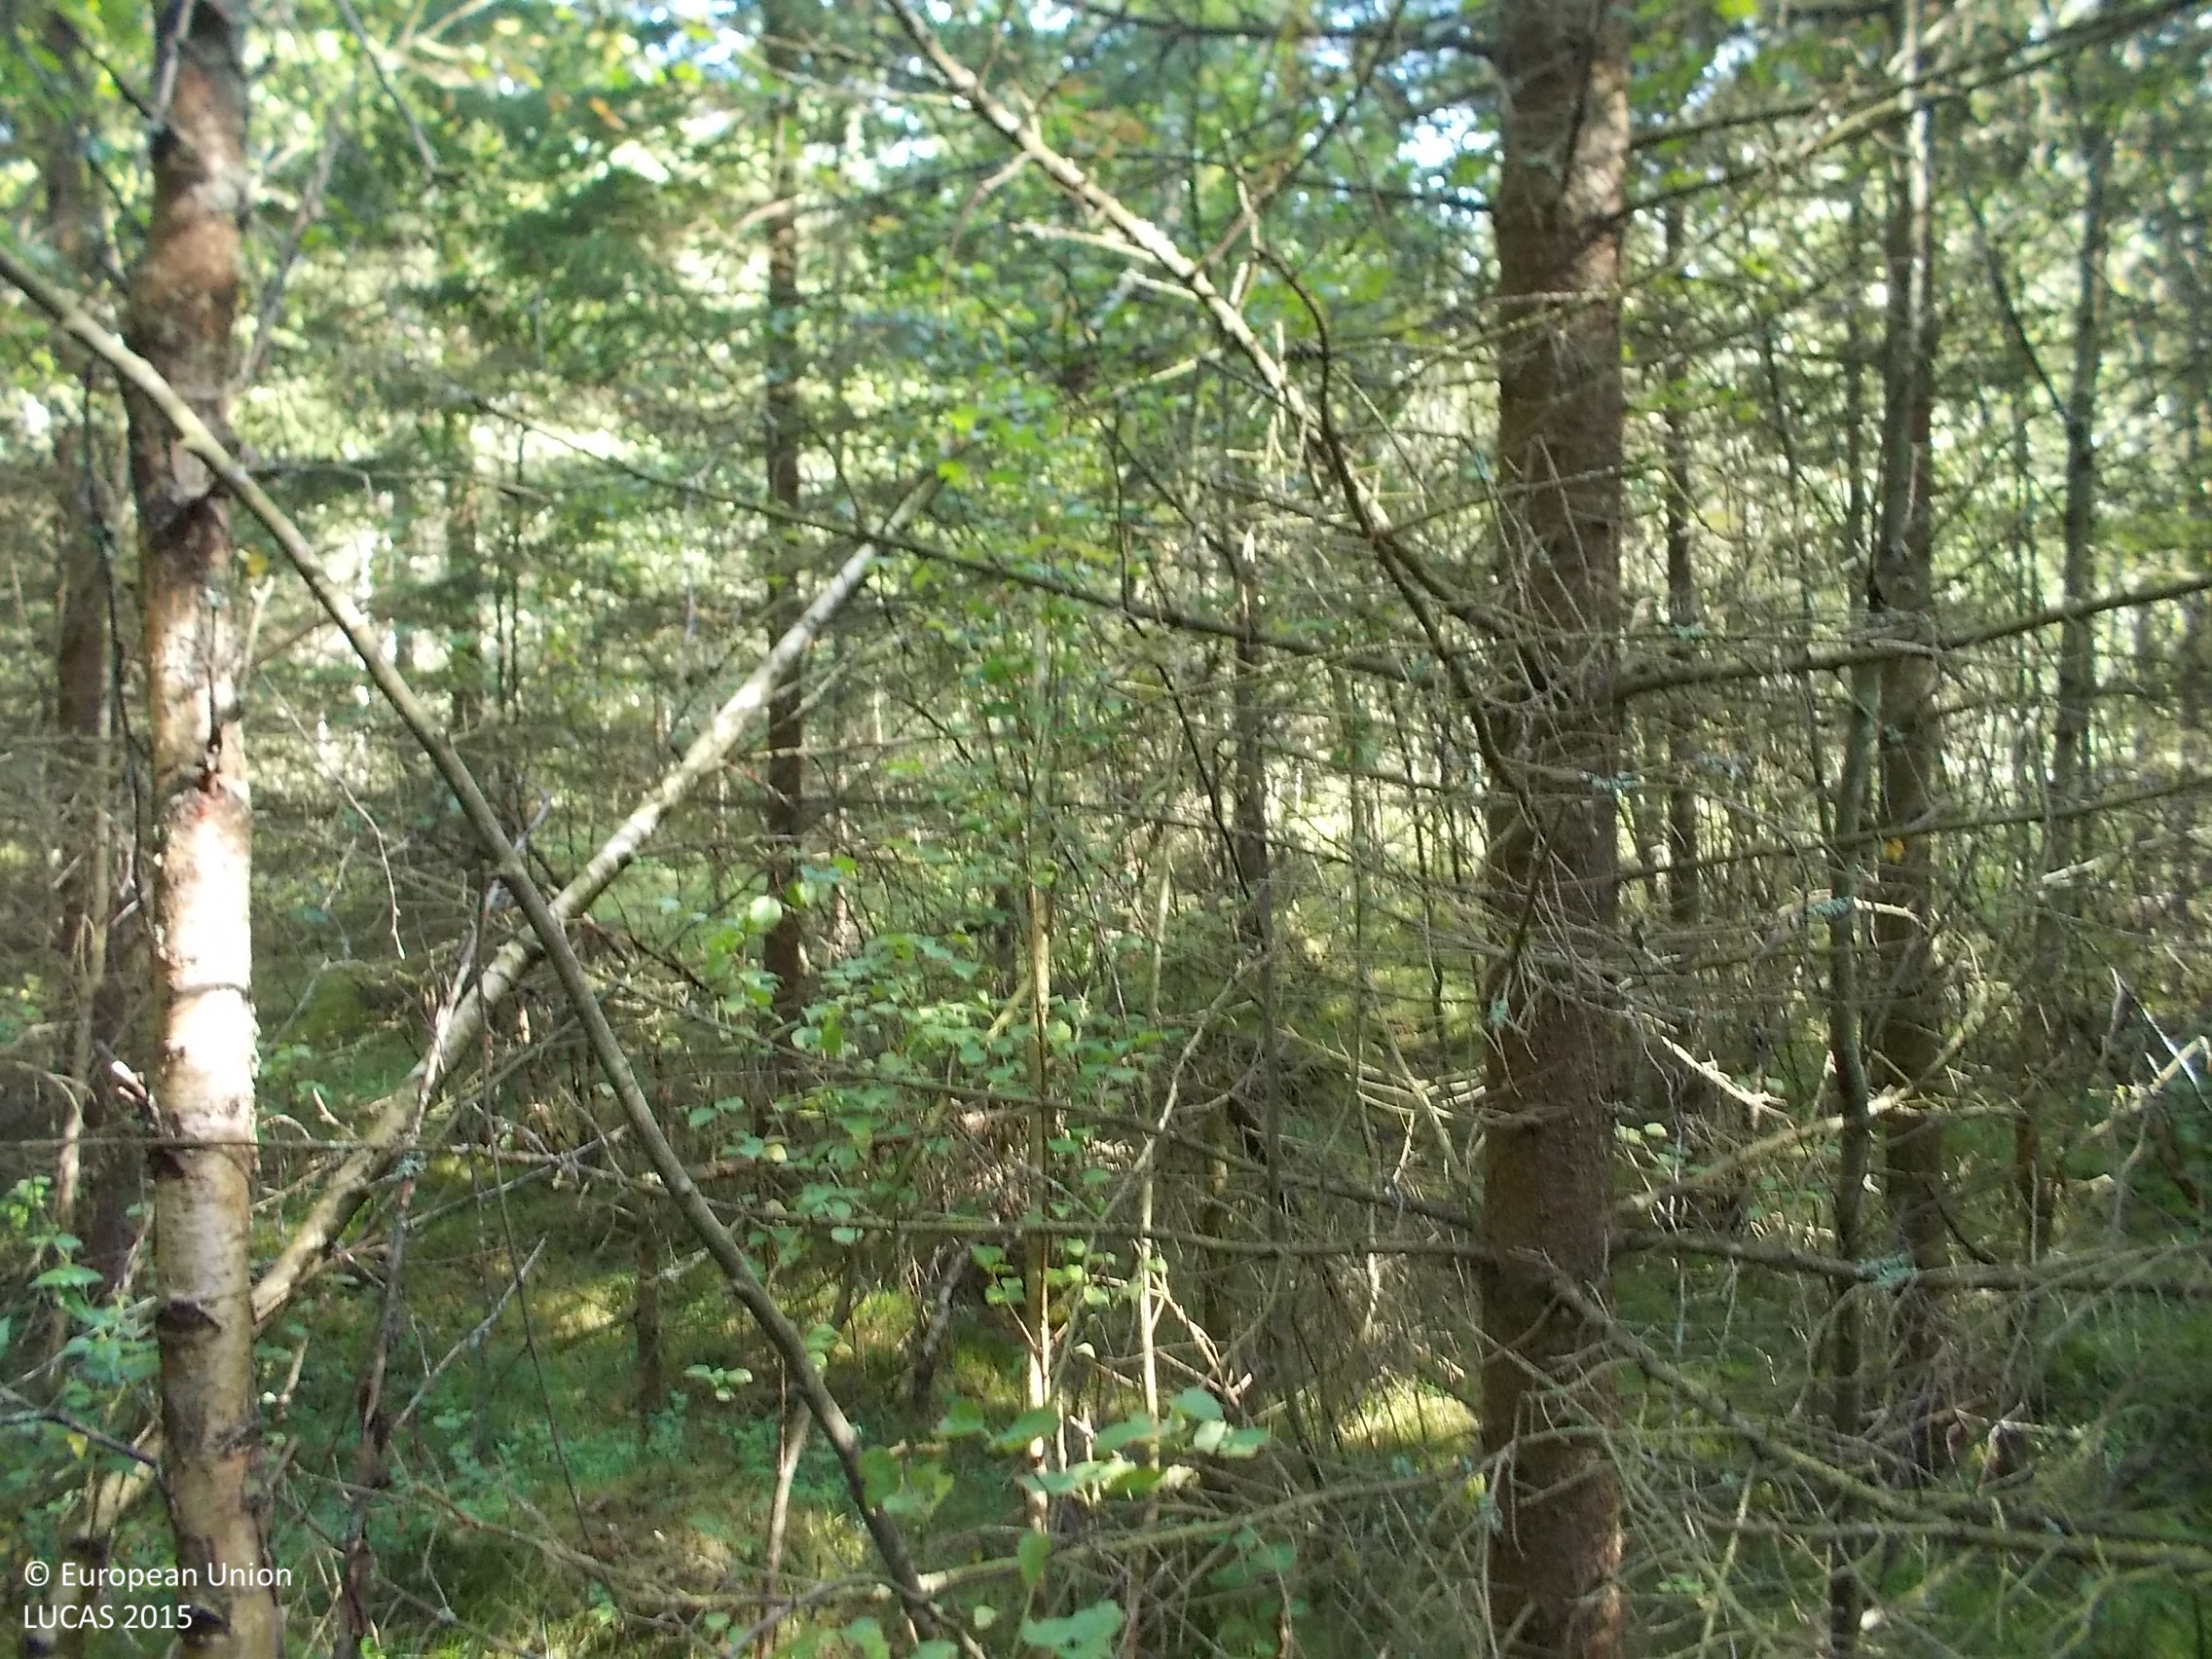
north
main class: Woodland
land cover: Spruce dominated mixed woodland
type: boreal forest
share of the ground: > 75 %
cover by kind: coniferous forest trees 60 %, broadleaved forest trees 30 %, shrubs 5 %, lichens and mosses 5 %
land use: Forestry
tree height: > 5 m
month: August
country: SE
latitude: 57.6439
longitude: 13.0949
